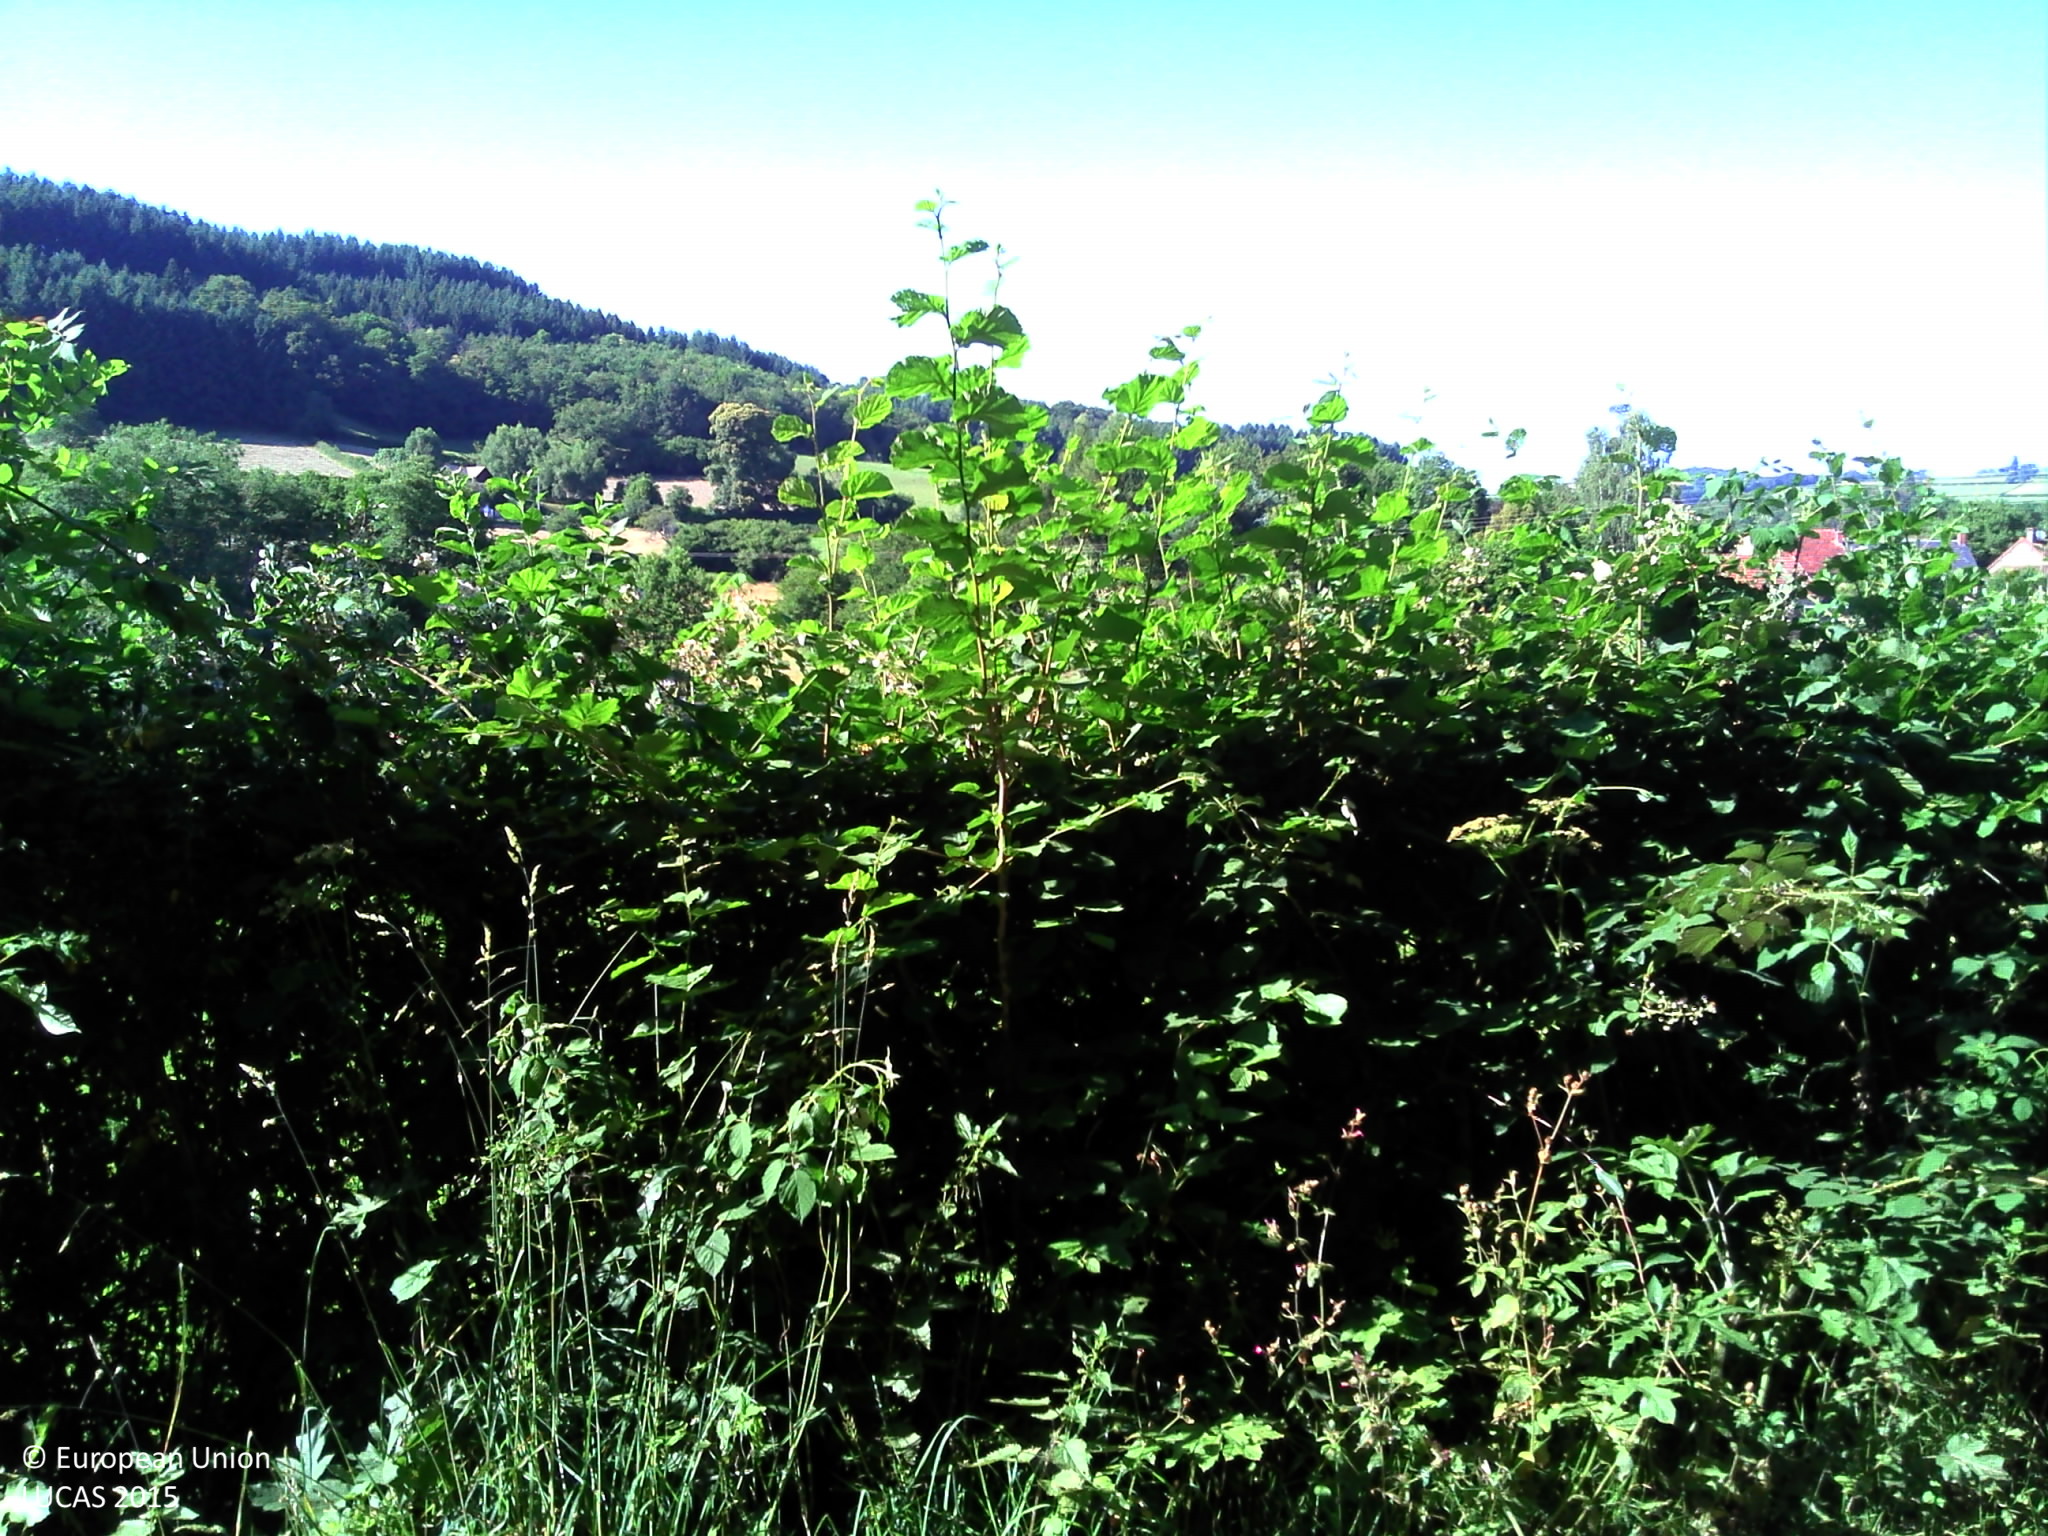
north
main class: Woodland
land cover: Broadleaved woodland
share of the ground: 50 - 75 %
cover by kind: broadleaved forest trees 60 %, herbaceous plants 40 %
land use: Residential
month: June
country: FR
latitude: 47.1711
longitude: 3.9163
